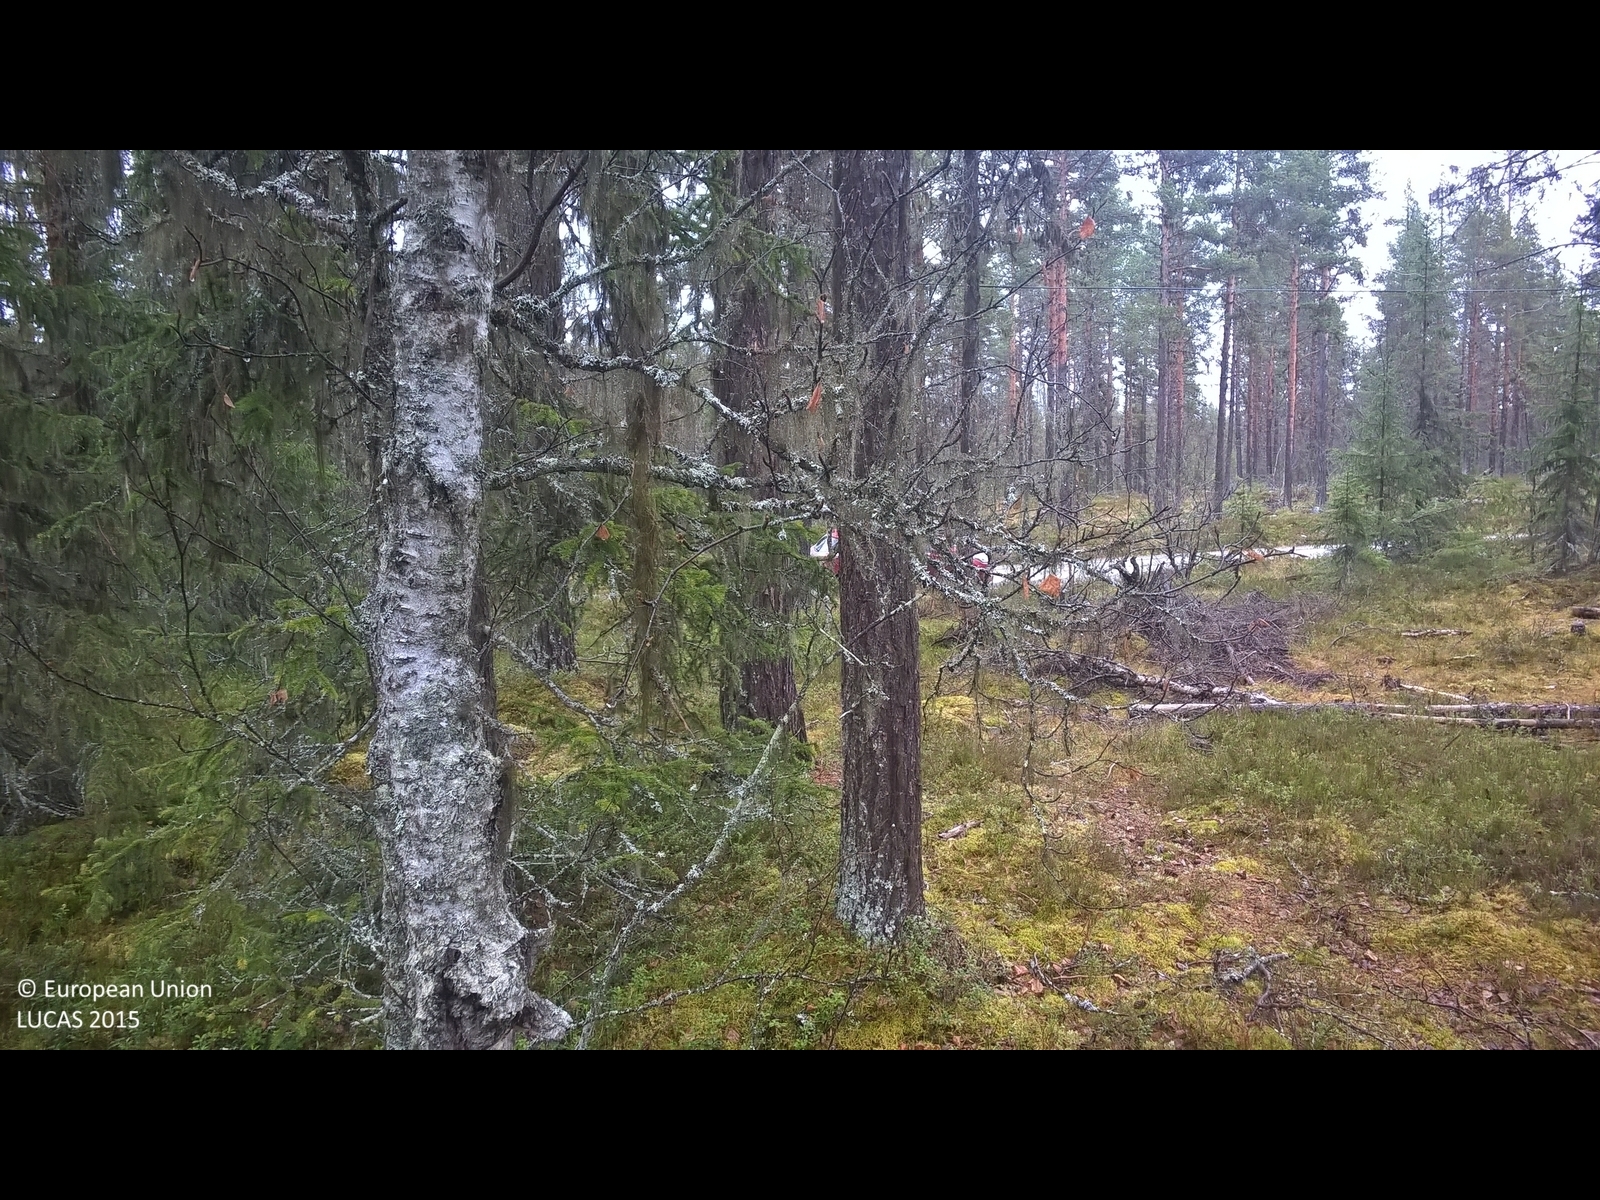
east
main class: Woodland
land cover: Pine dominated coniferous woodland
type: boreal forest
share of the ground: > 75 %
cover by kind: coniferous forest trees 75 %, lichens and mosses 20 %, broadleaved forest trees 5 %
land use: Forestry
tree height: > 5 m
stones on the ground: < 10 %
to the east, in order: Pine dominated coniferous woodland; Electric lines; Ditches and canals; Paved roads, cycling and walking lanes; Ditches and canals; Other mixed woodland; Pine dominated coniferous woodland; Rivers and streams; Other mixed woodland; Pine dominated coniferous woodland; Other mixed woodland
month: November
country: SE
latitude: 62.8169
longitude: 13.8087
